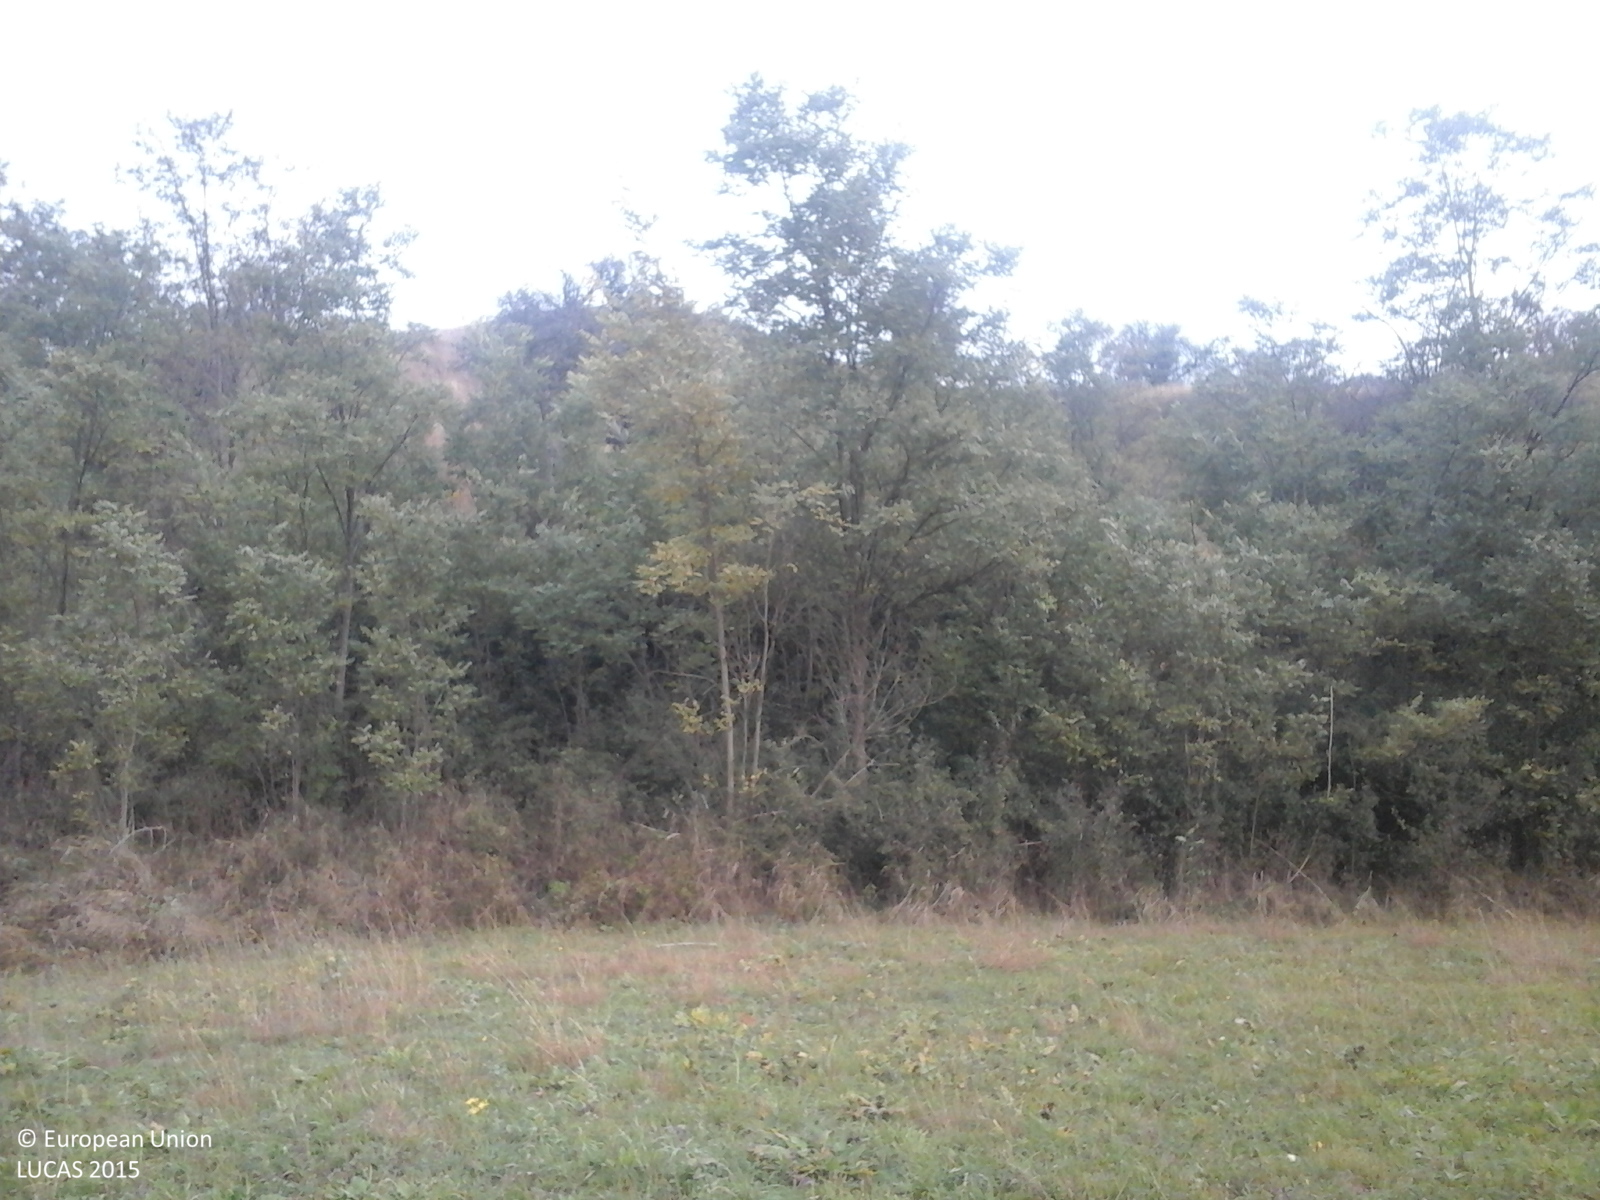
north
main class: Grassland
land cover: Grassland without tree/shrub cover
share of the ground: > 75 %
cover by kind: herbaceous plants 100 %
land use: Agriculture (excluding fallow land and kitchen gardens)
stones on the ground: < 10 %
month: October
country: RO
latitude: 45.8163
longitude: 24.7457
